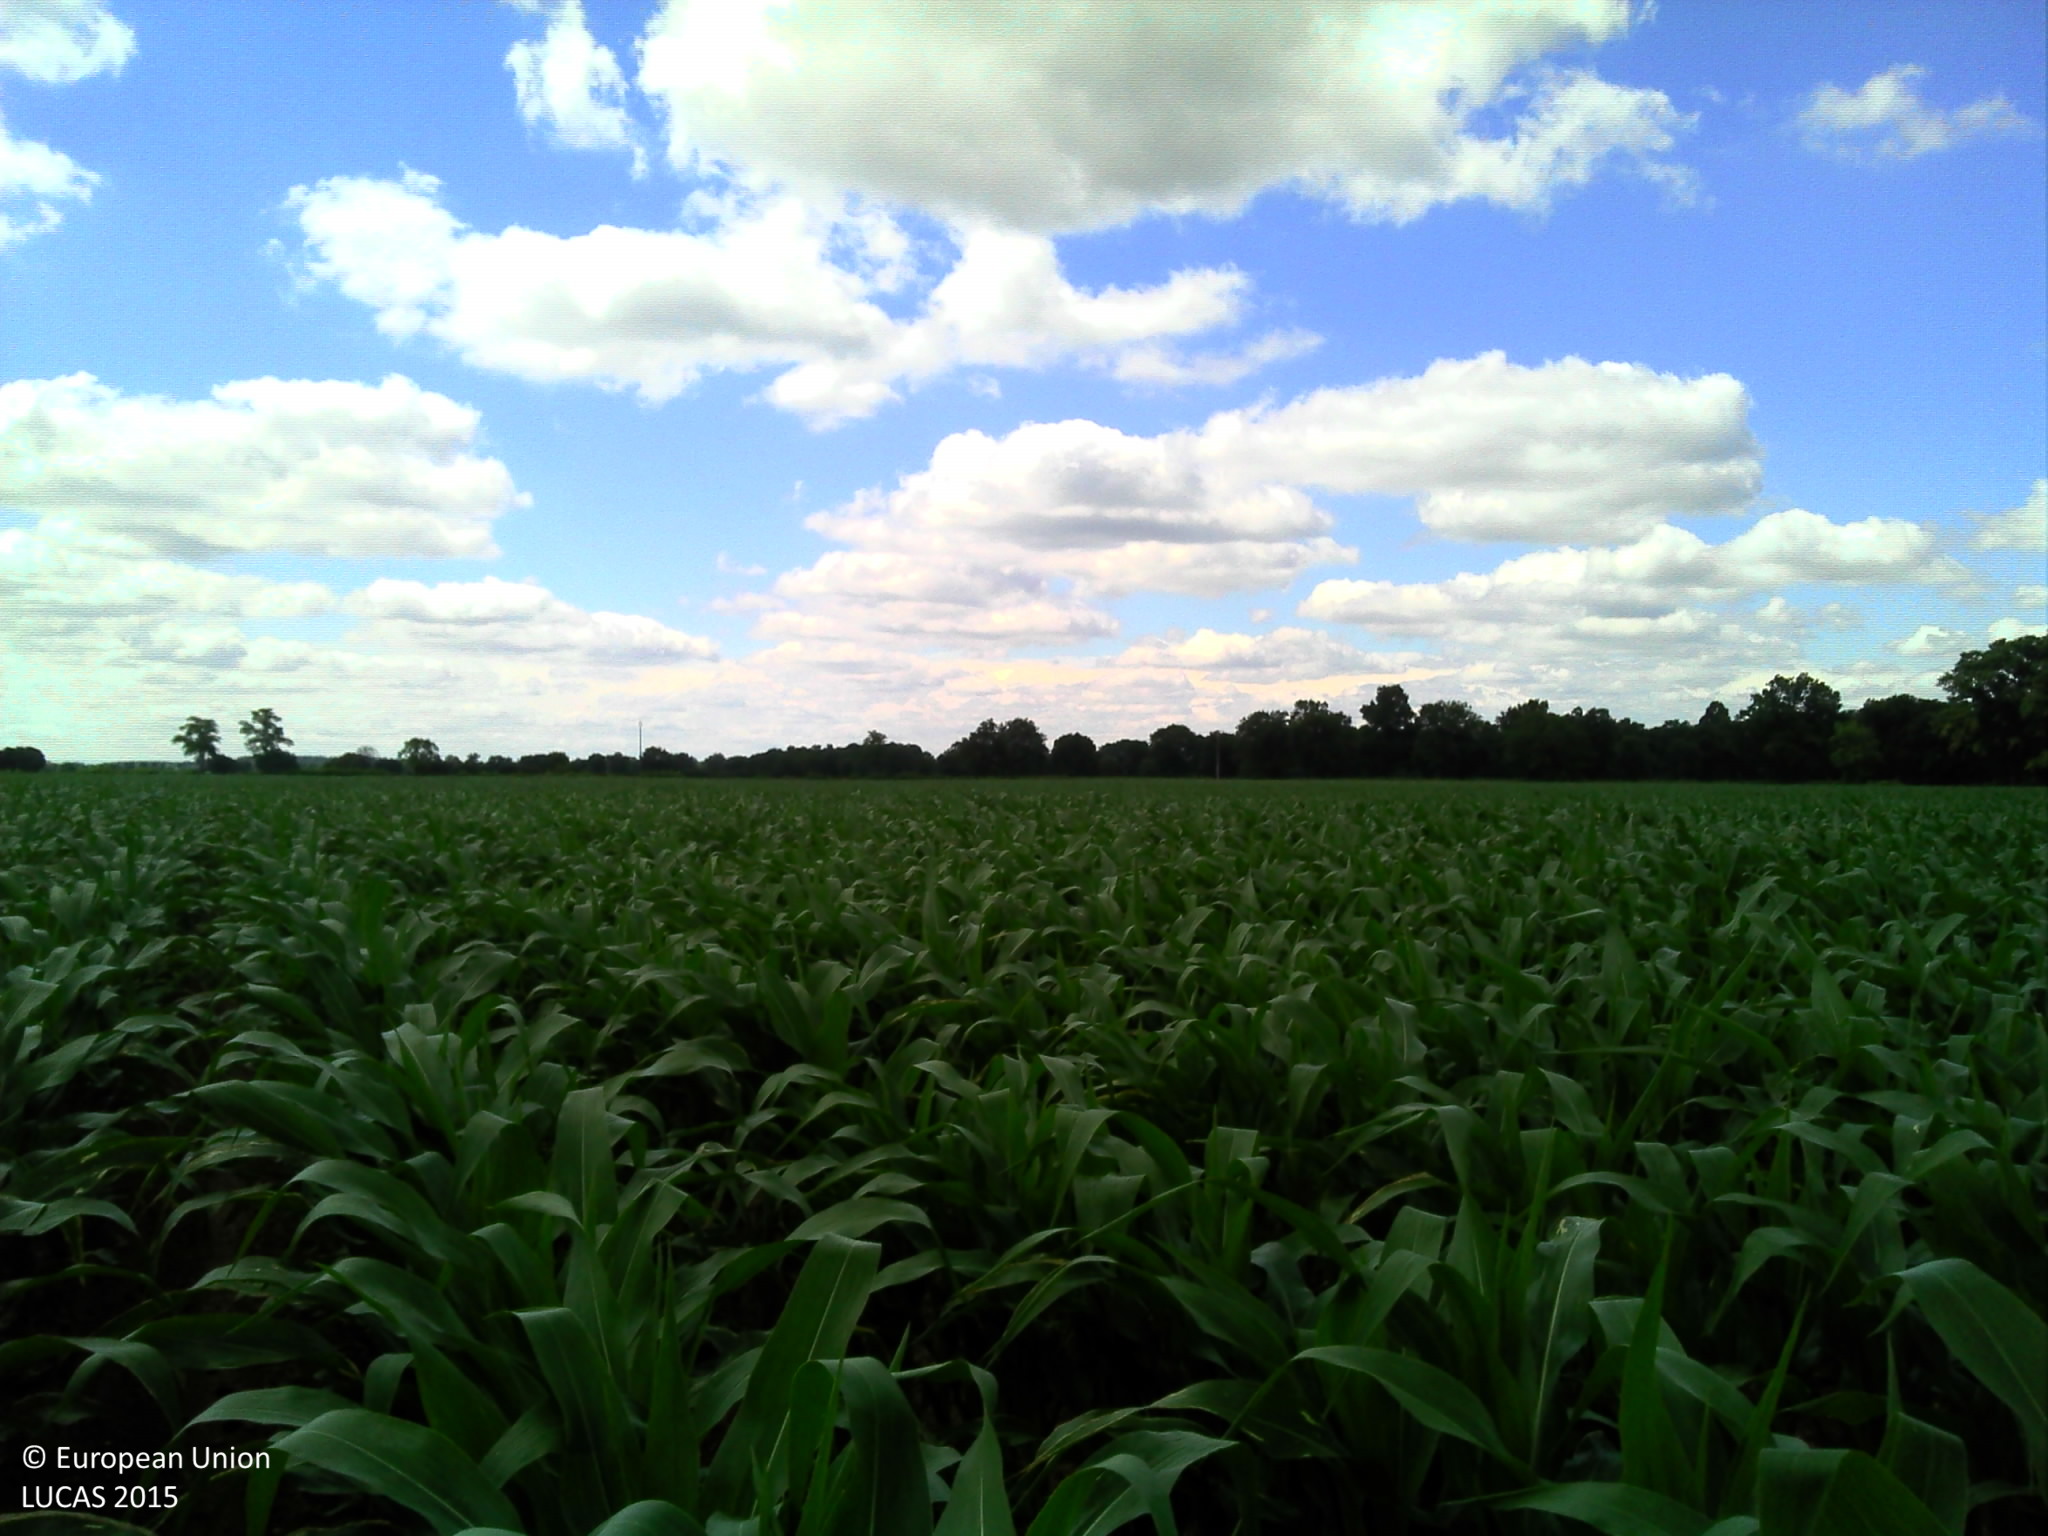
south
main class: Cropland
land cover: Maize
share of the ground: > 75 %
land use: Agriculture (excluding fallow land and kitchen gardens)
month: June
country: FR
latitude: 46.7032
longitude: 3.6292
